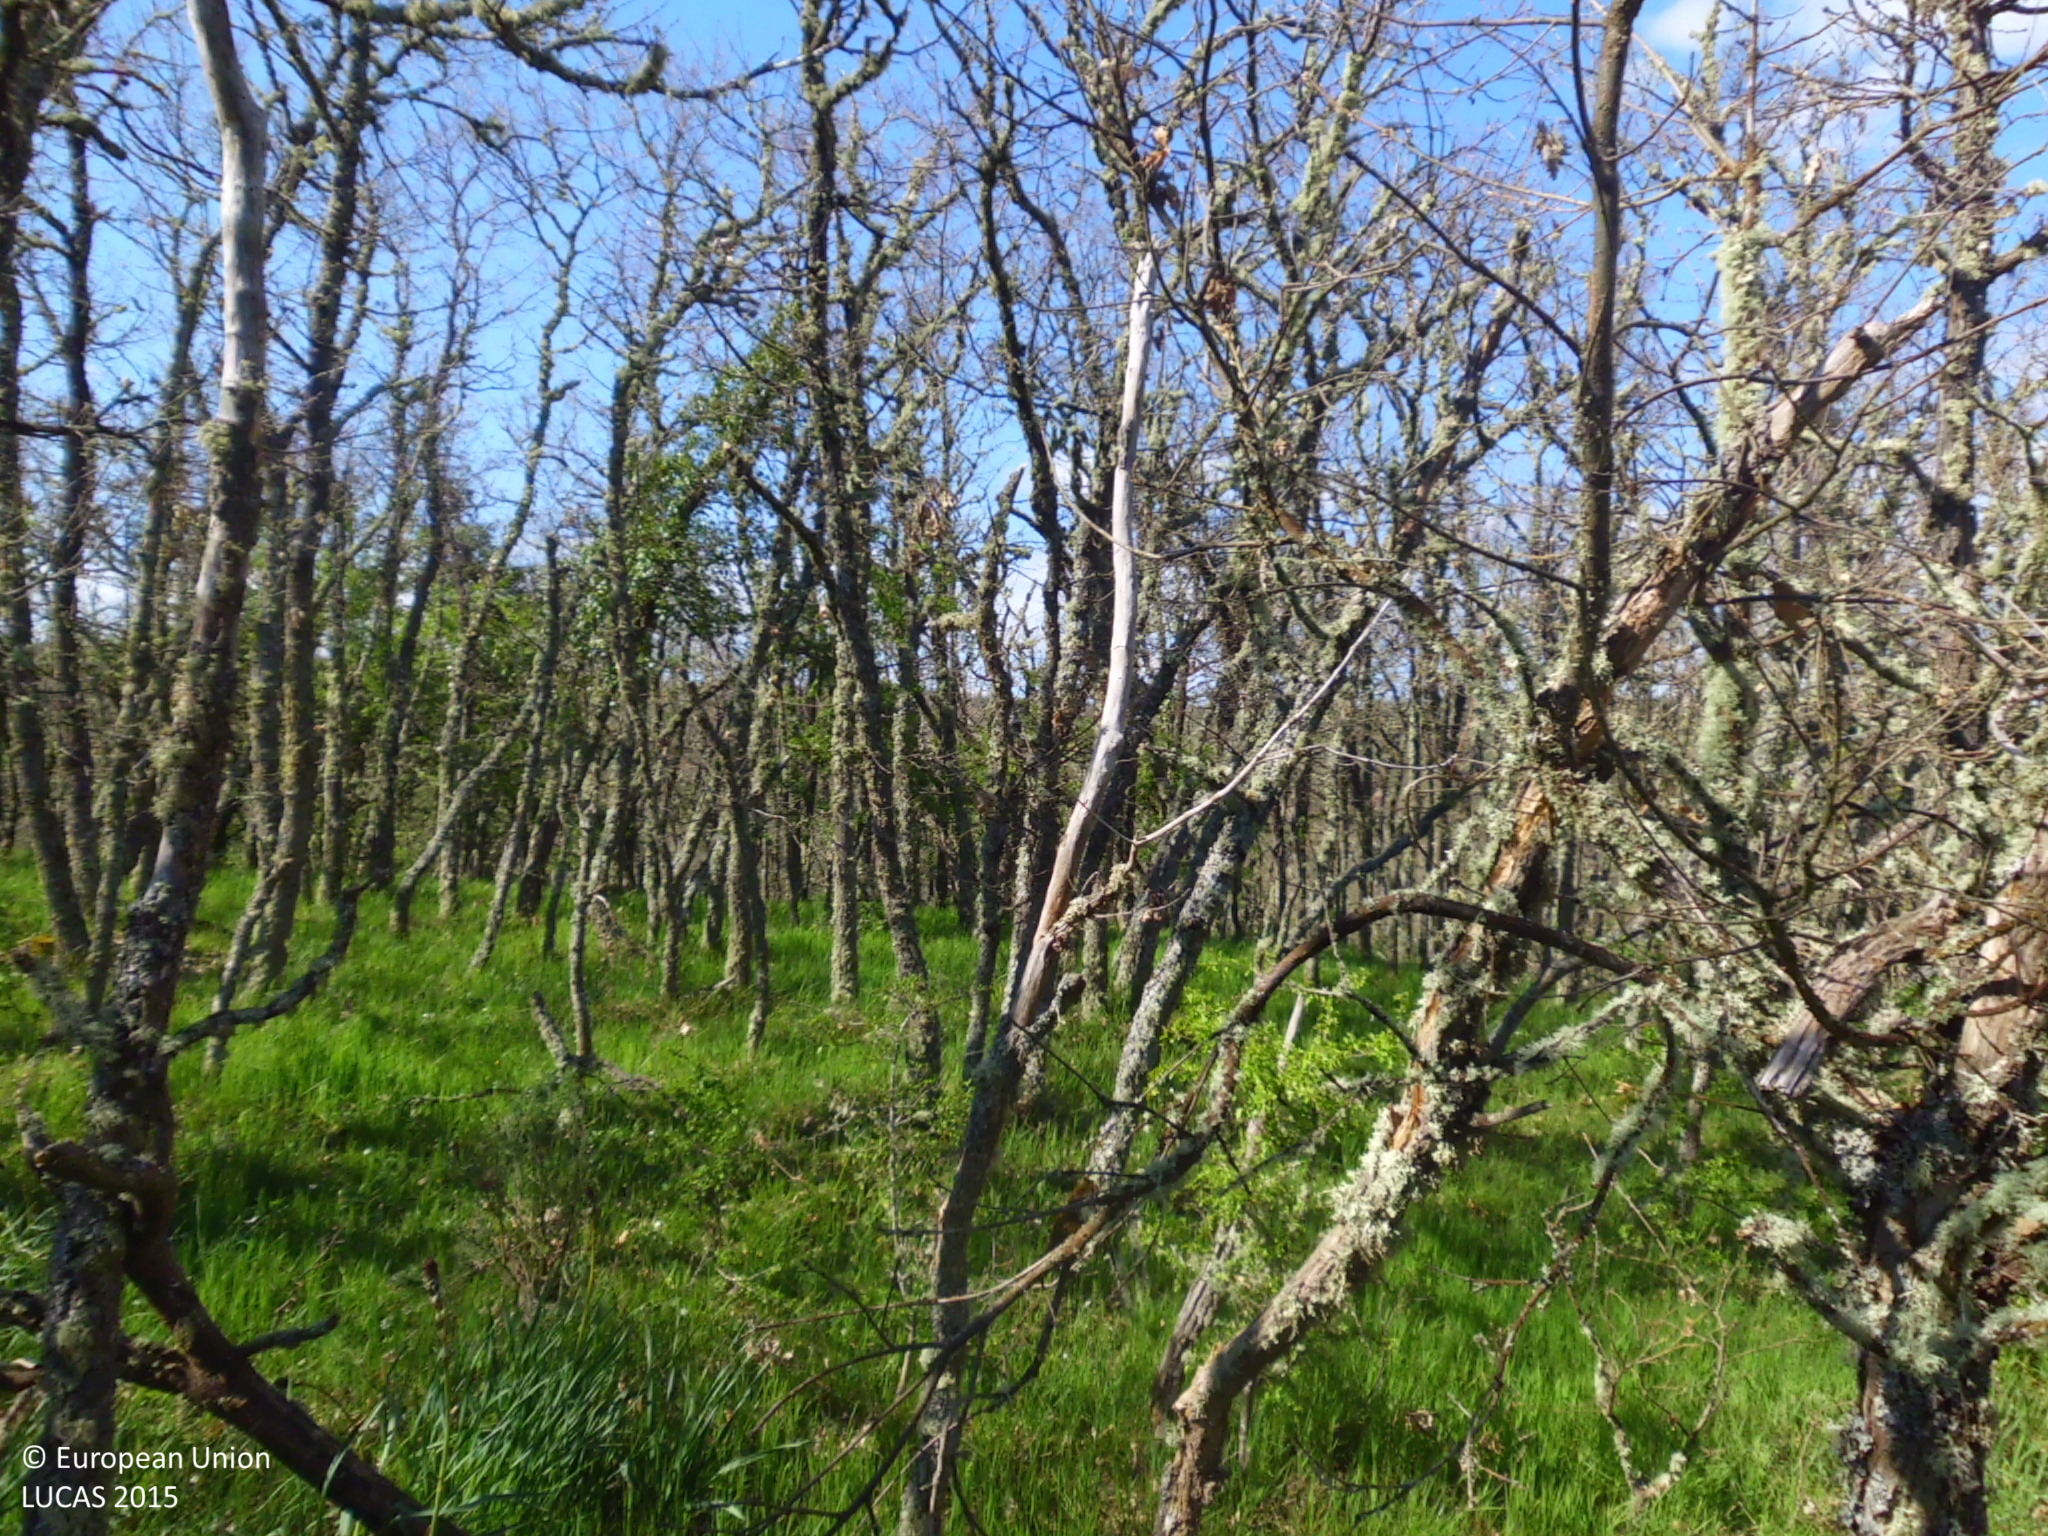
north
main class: Woodland
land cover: Broadleaved woodland
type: acidophilous oak and oak-birch forest
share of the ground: > 75 %
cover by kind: broadleaved forest trees 85 %, shrubs 10 %, herbaceous plants 5 %
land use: Semi-natural and natural areas not in use
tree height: < 5 m
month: May
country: ES
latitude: 42.8185
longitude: -4.0759
